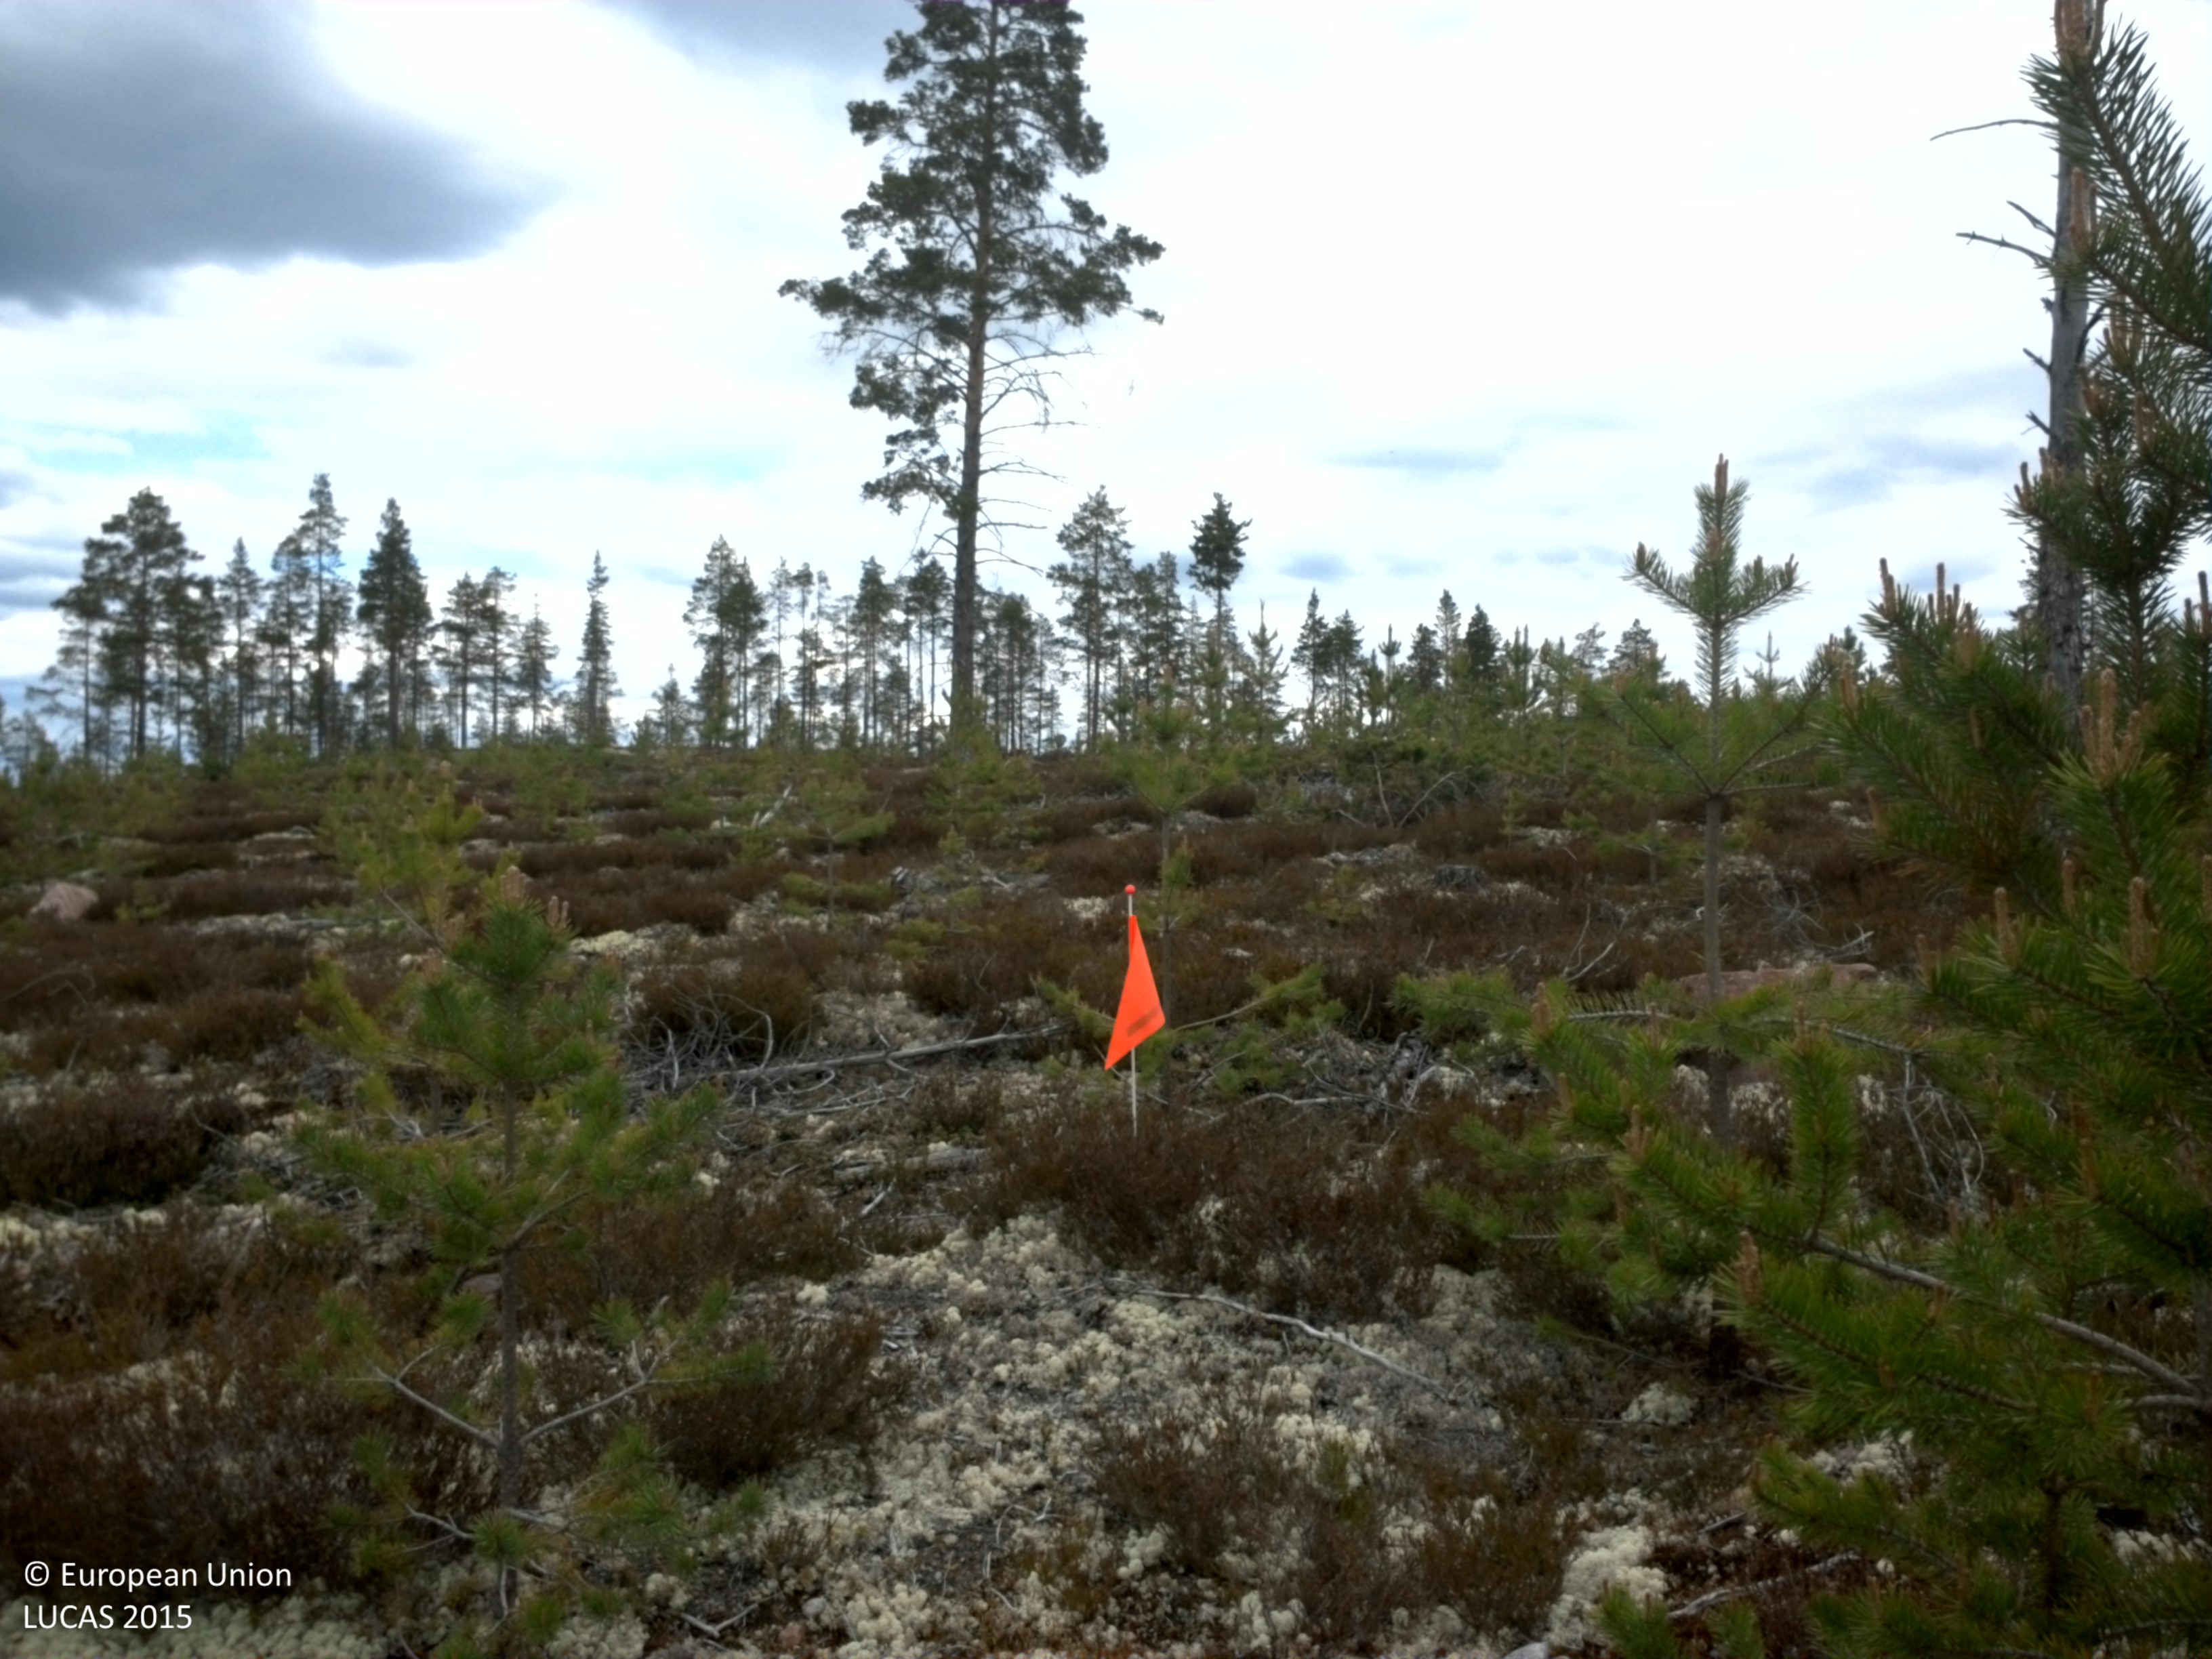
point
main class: Woodland
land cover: Pine dominated coniferous woodland
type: boreal forest
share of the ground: 10 - 25 %
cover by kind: lichens and mosses 30 %, coniferous forest trees 25 %, consolidated bare surface 20 %, shrubs 15 %, herbaceous plants 10 %
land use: Forestry
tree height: < 5 m
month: June
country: SE
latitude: 61.5638
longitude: 13.3948
